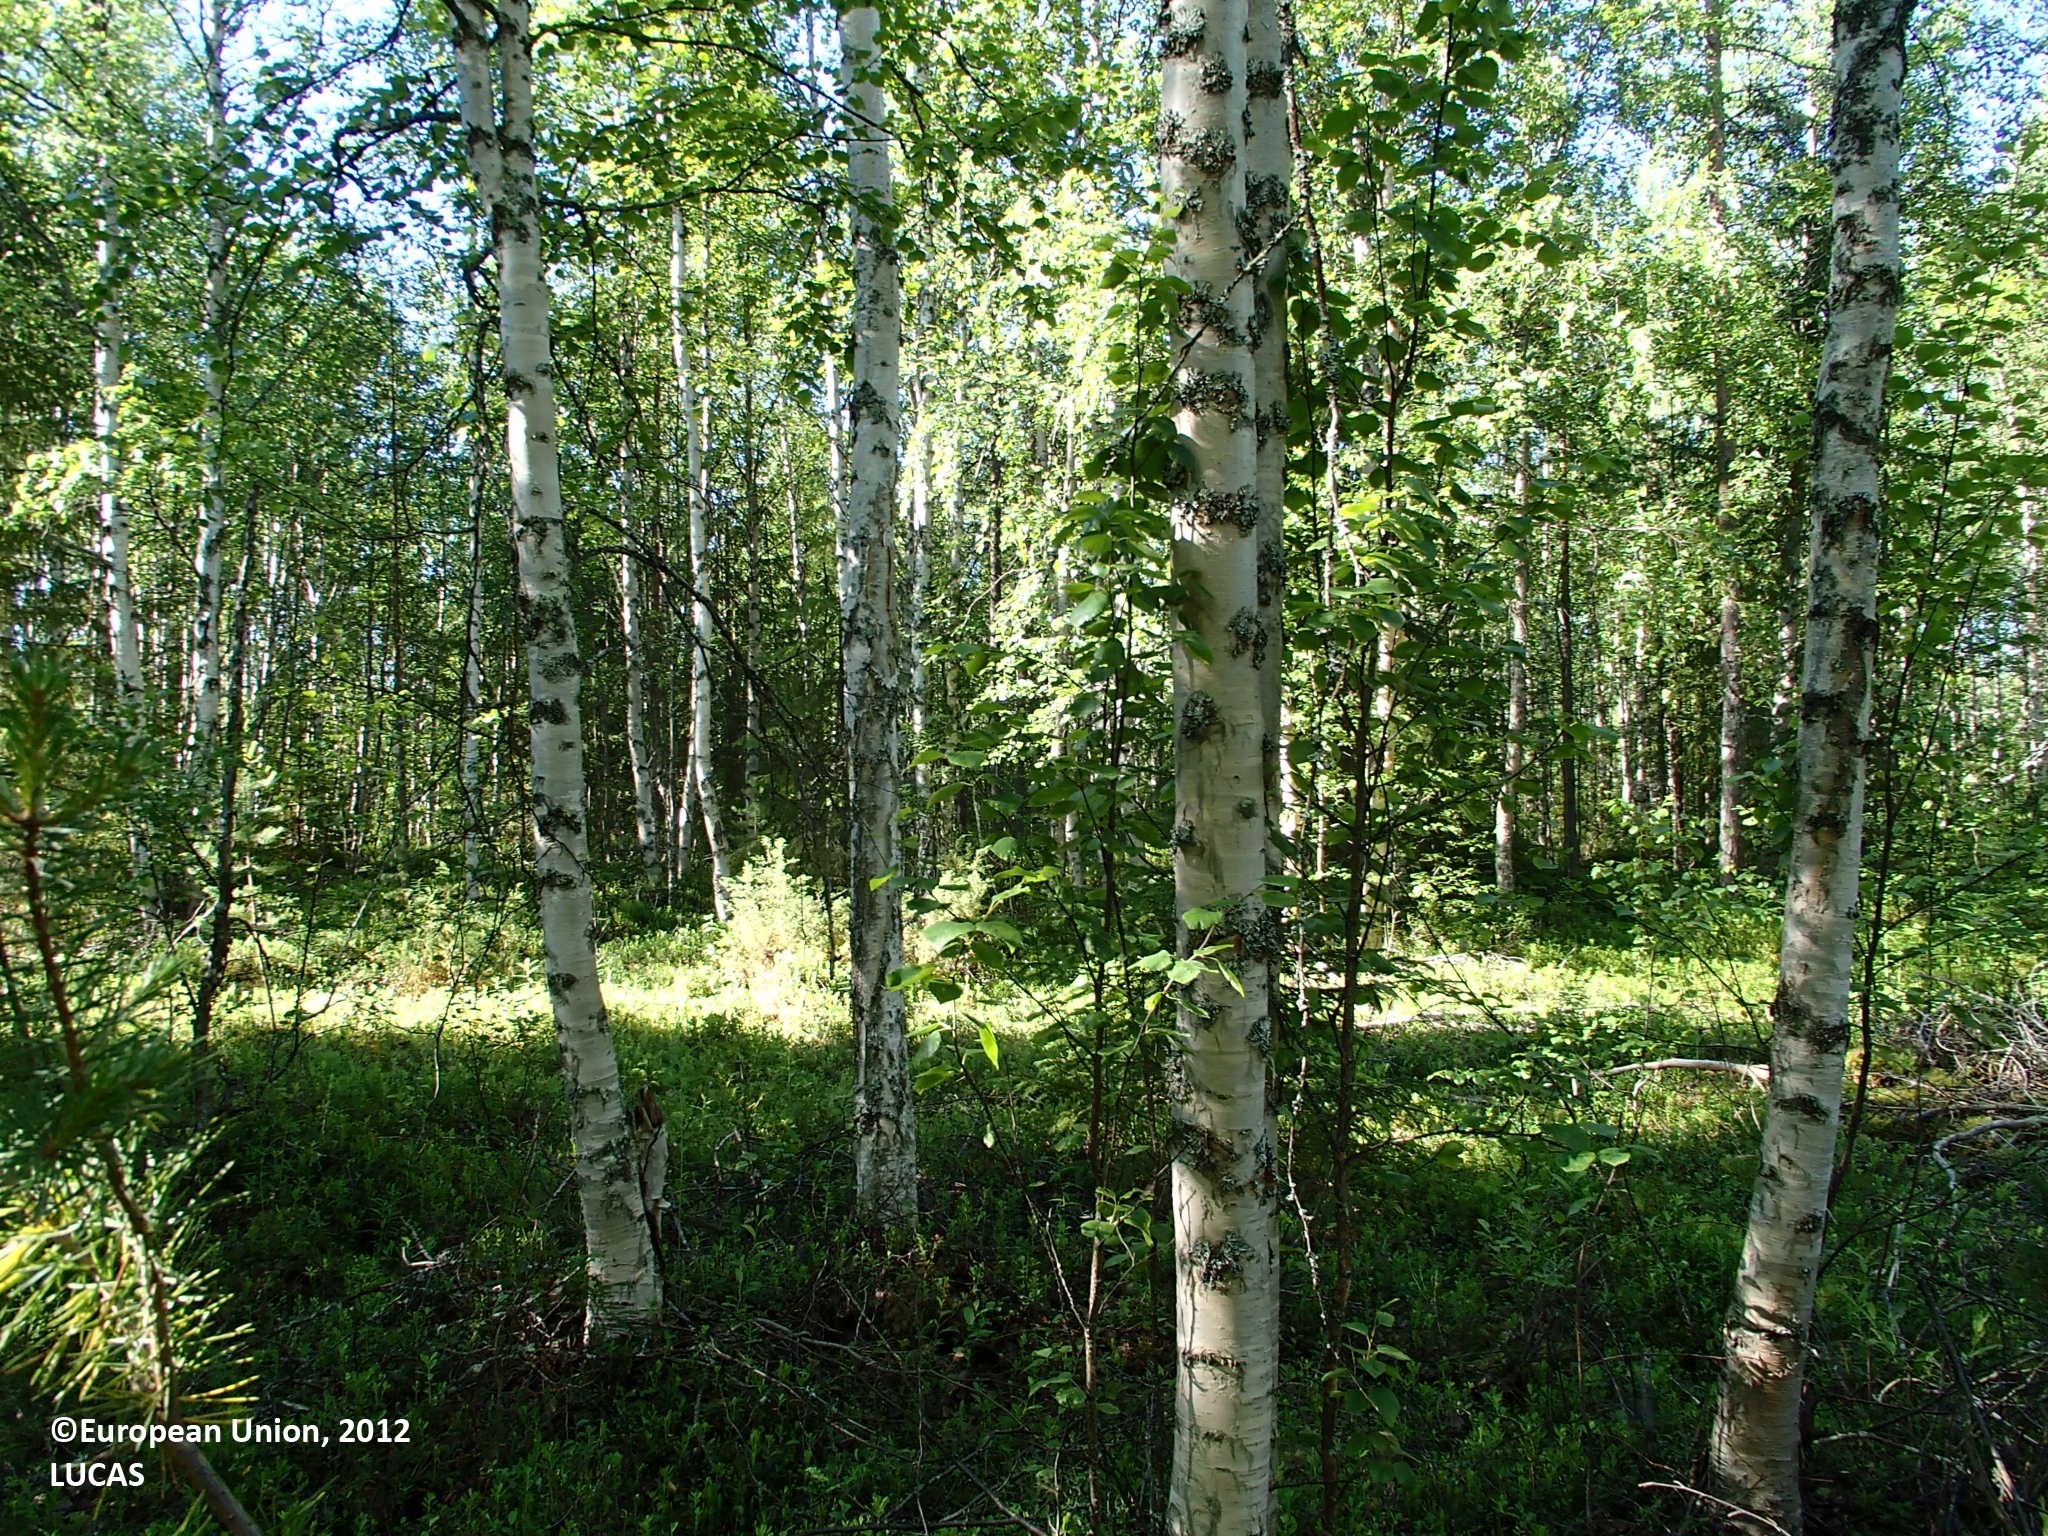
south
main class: Woodland
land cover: Other mixed woodland
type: boreal forest
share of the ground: > 75 %
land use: Forestry
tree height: > 5 m
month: July
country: FI
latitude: 66.8564
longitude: 25.4478
